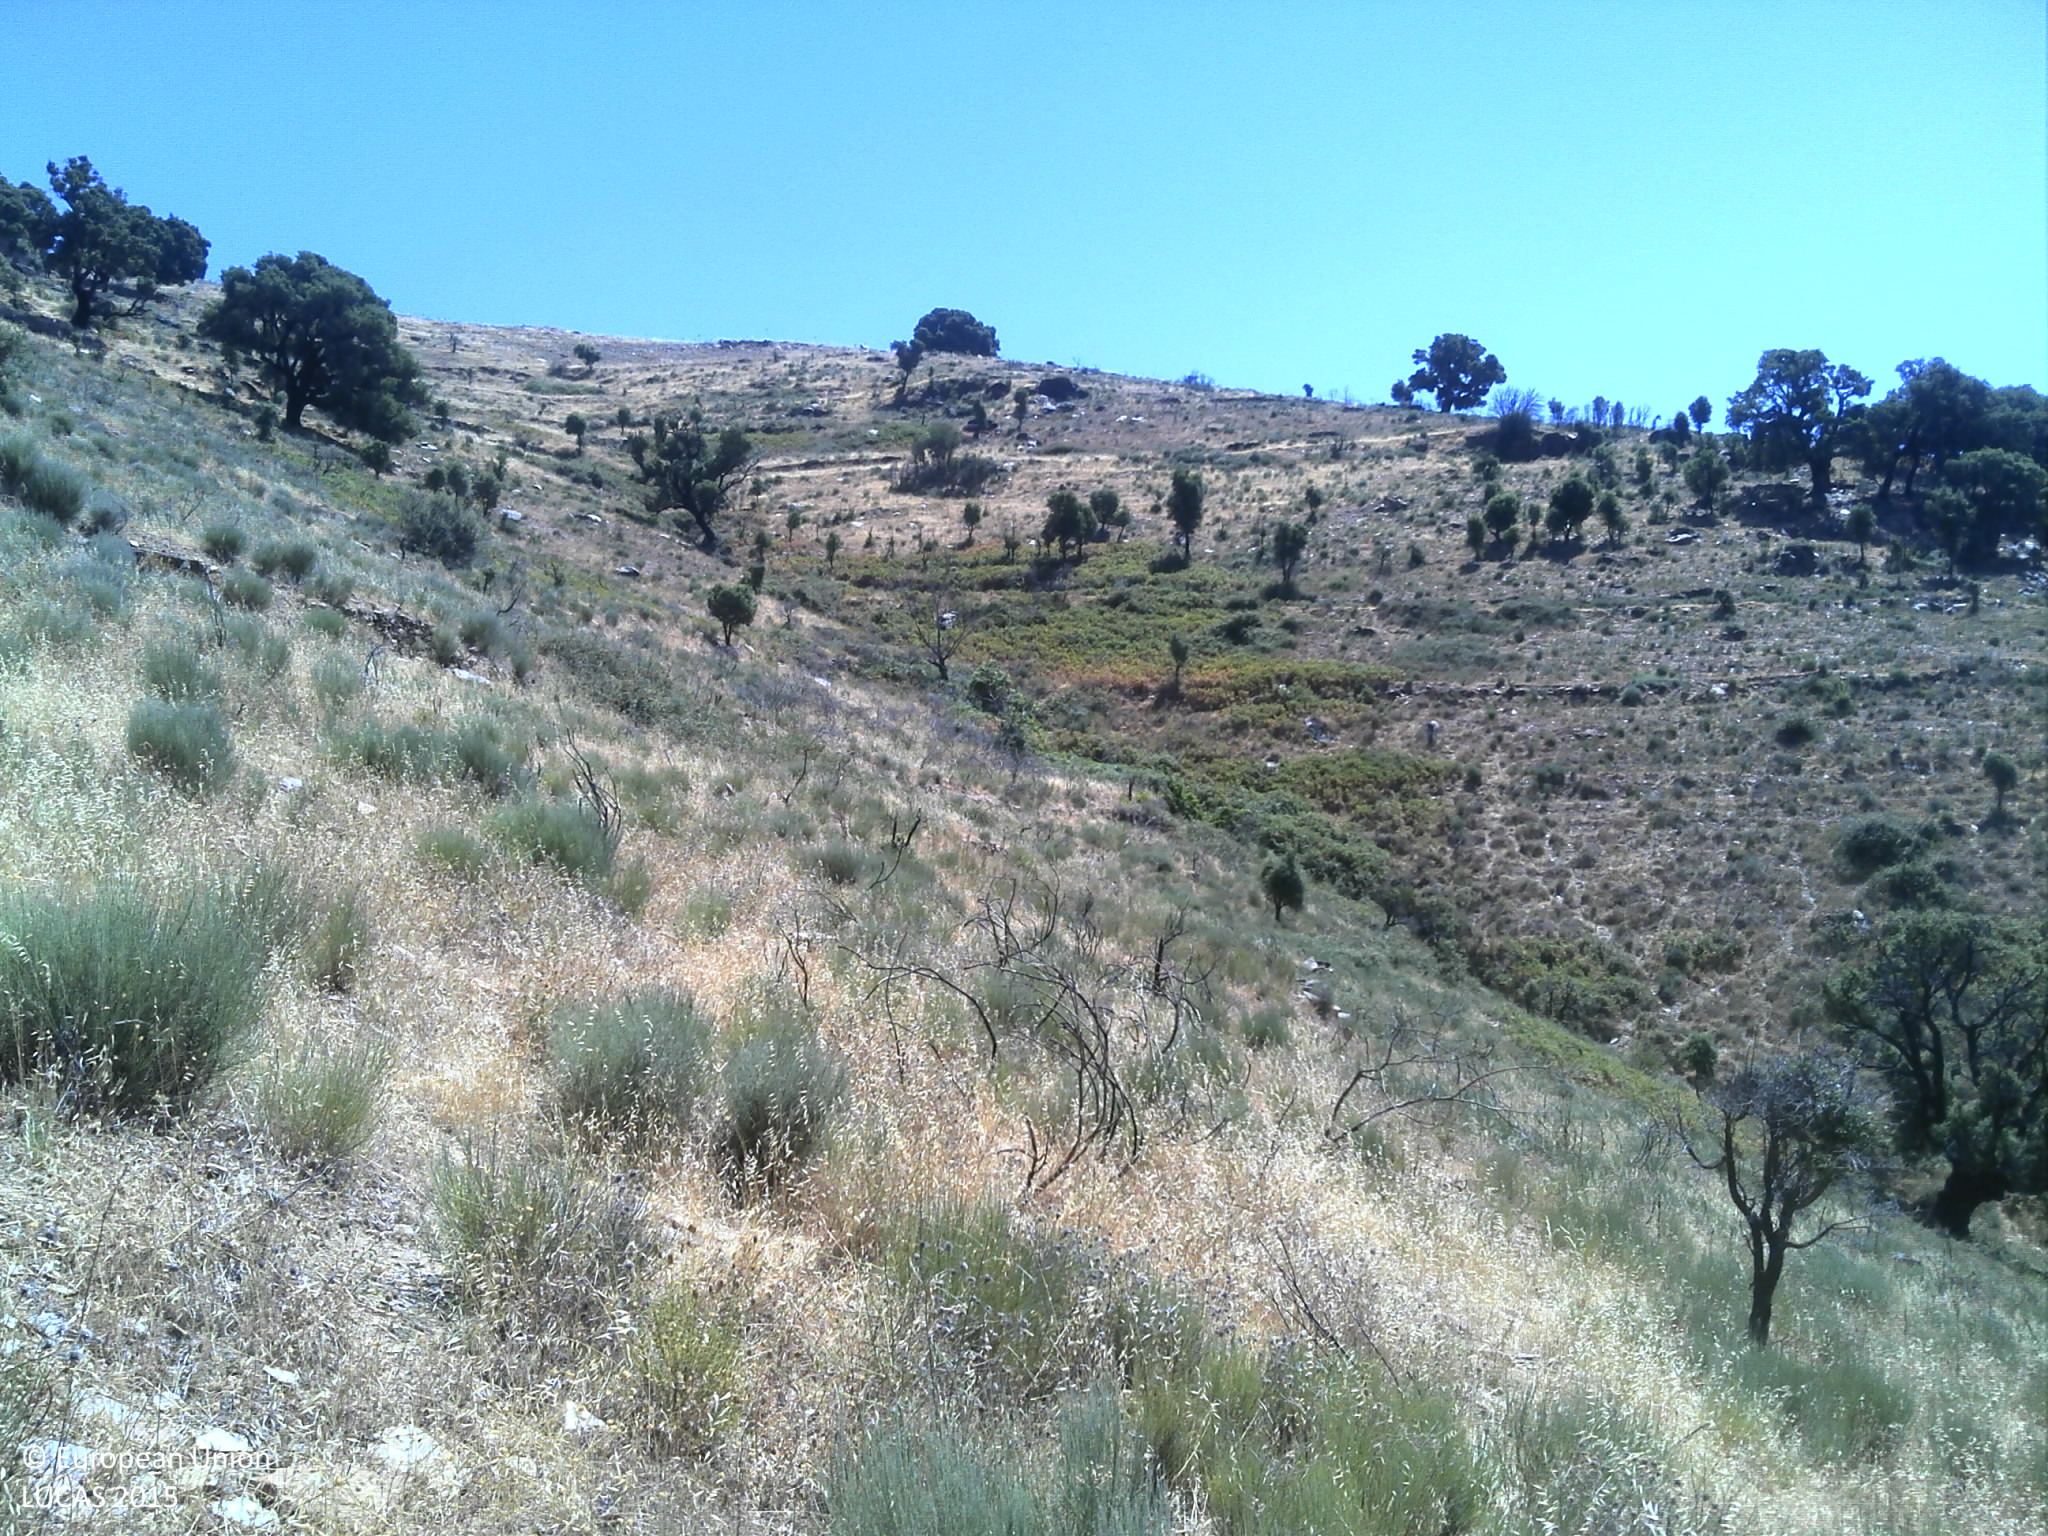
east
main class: Shrubland
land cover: Shrubland without tree cover
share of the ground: > 75 %
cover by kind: shrubs 75 %, unconsolidated bare surface 15 %, herbaceous plants 10 %
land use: Abandoned areas
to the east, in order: Shrubland without tree cover; Grassland with sparse tree/shrub cover; Rivers and streams; Grassland with sparse tree/shrub cover; Dry stone walls; Shrubland without tree cover; Shrubland with sparse tree cover; Grassland with sparse tree/shrub cover; Rock outcrops; Grassland with sparse tree/shrub cover
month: July
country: PT
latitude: 41.4219
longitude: -7.0206
